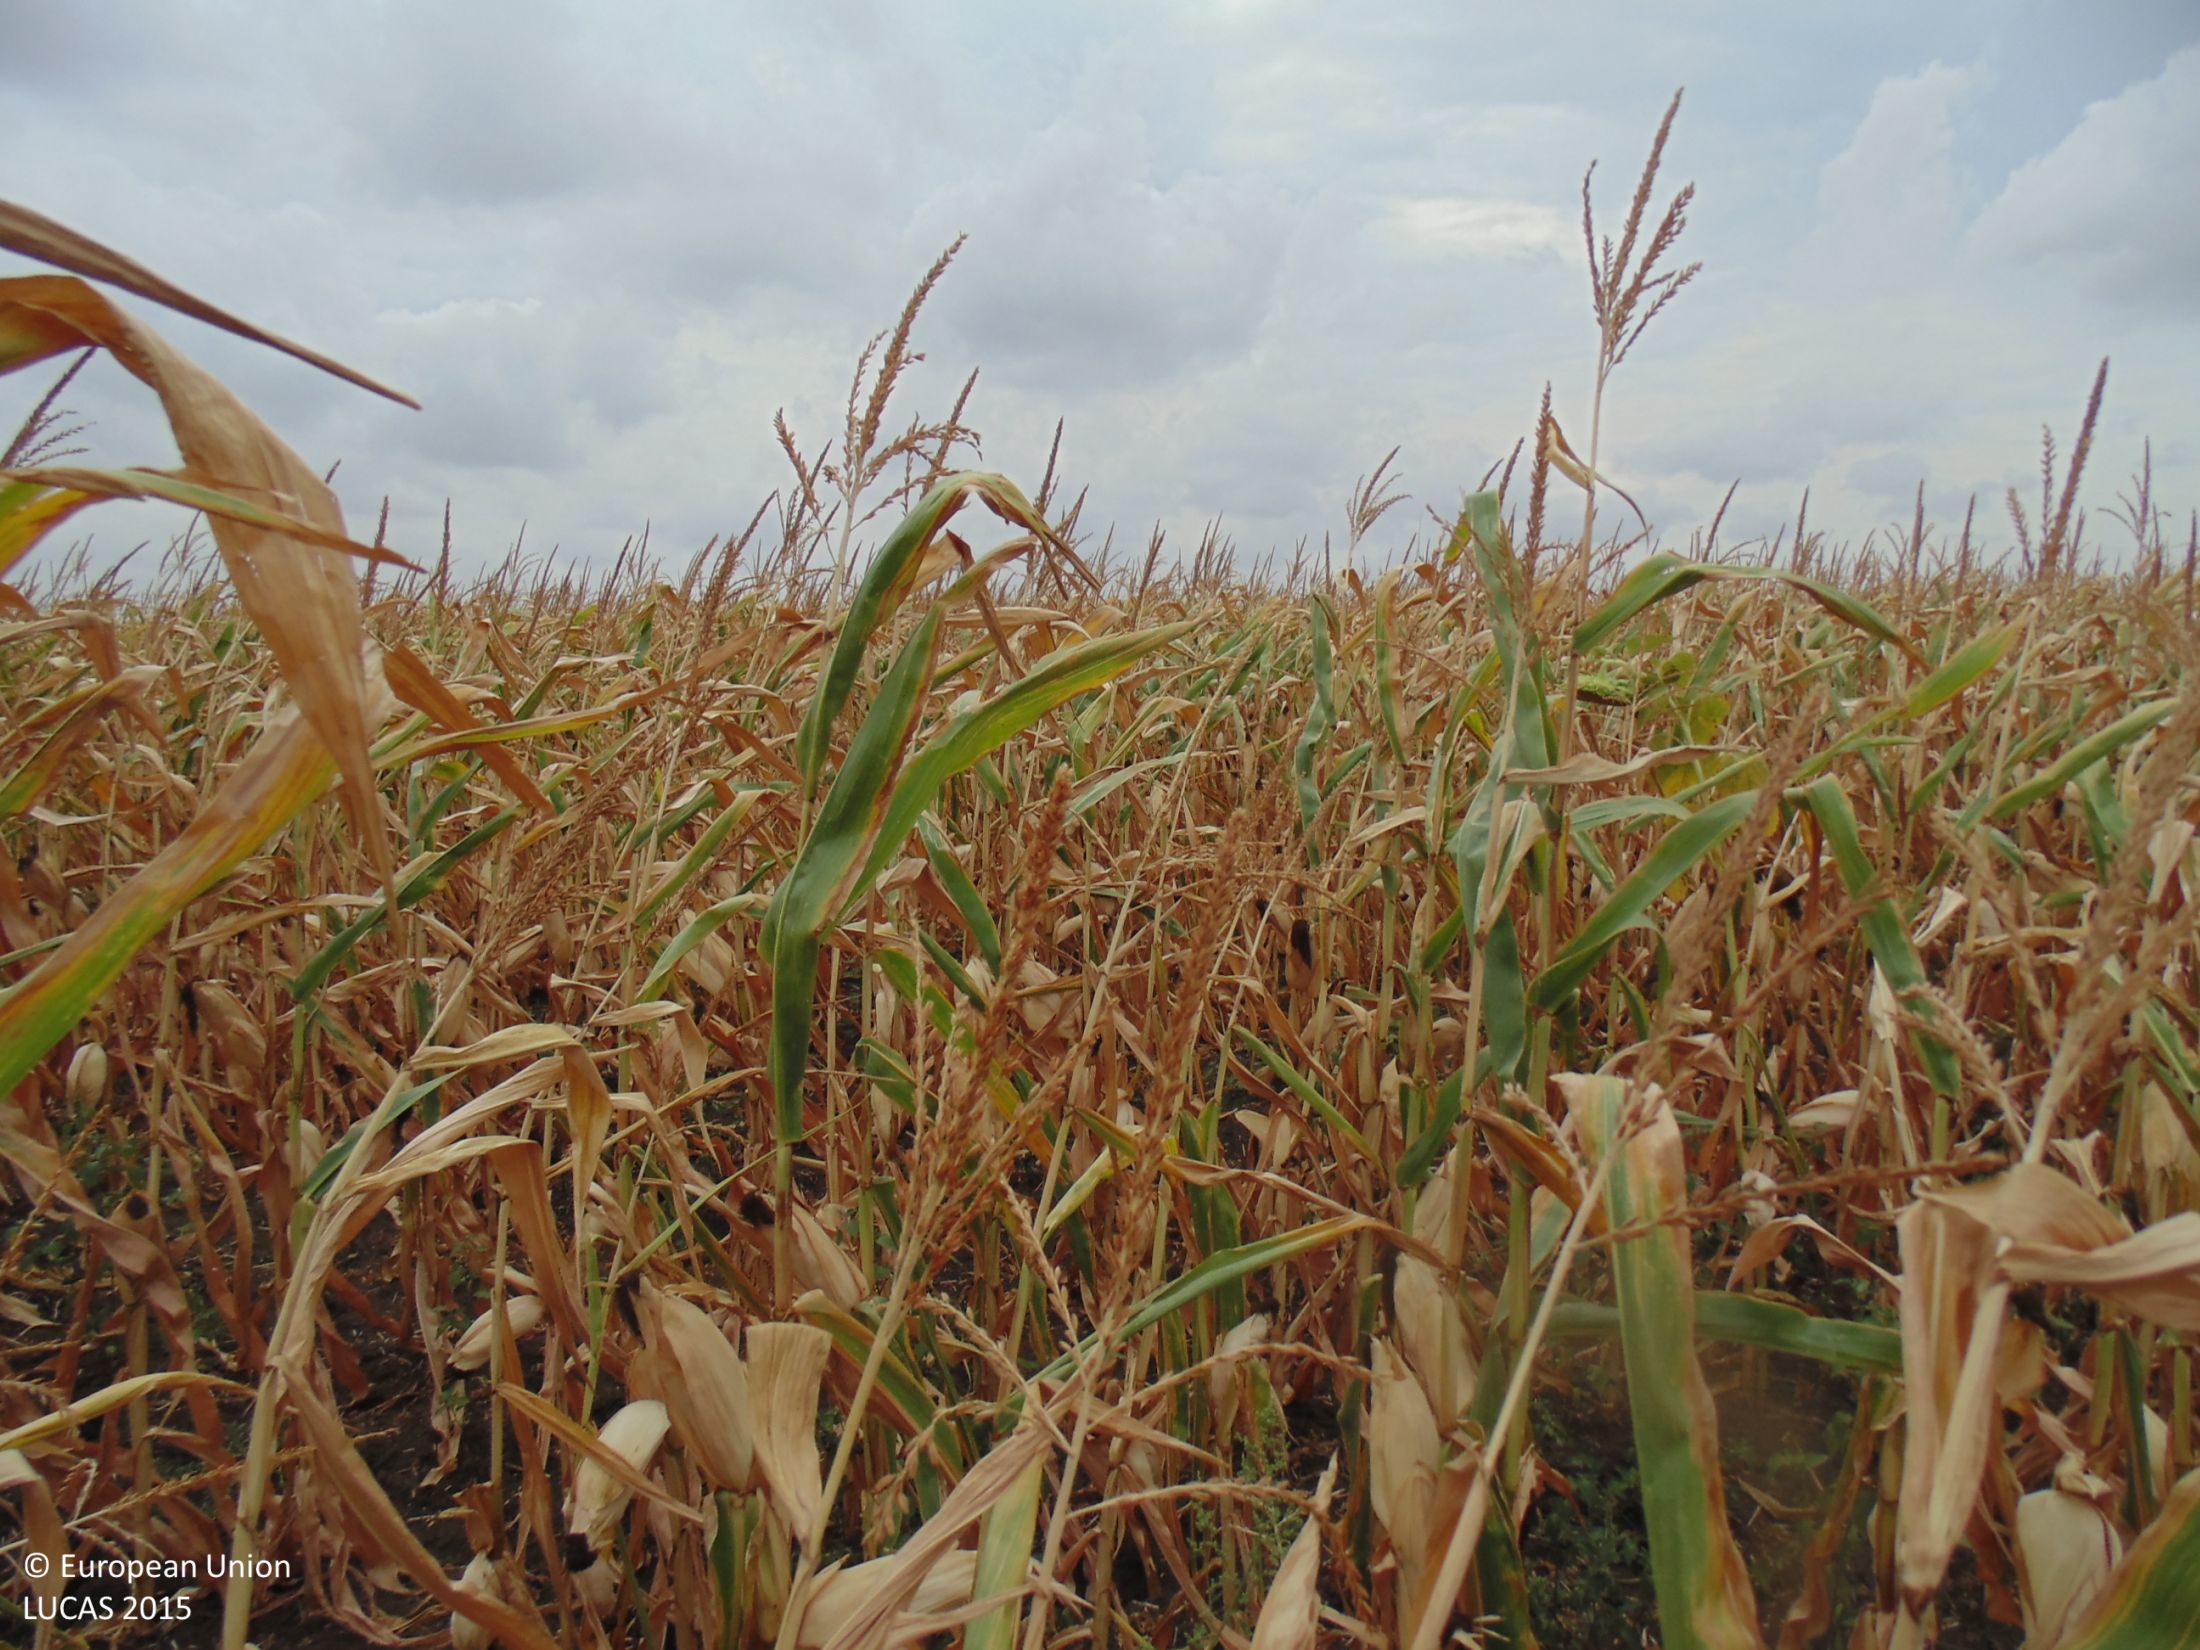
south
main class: Cropland
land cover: Maize
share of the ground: > 75 %
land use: Agriculture (excluding fallow land and kitchen gardens)
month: August
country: BG
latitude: 43.5261
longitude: 28.4595
